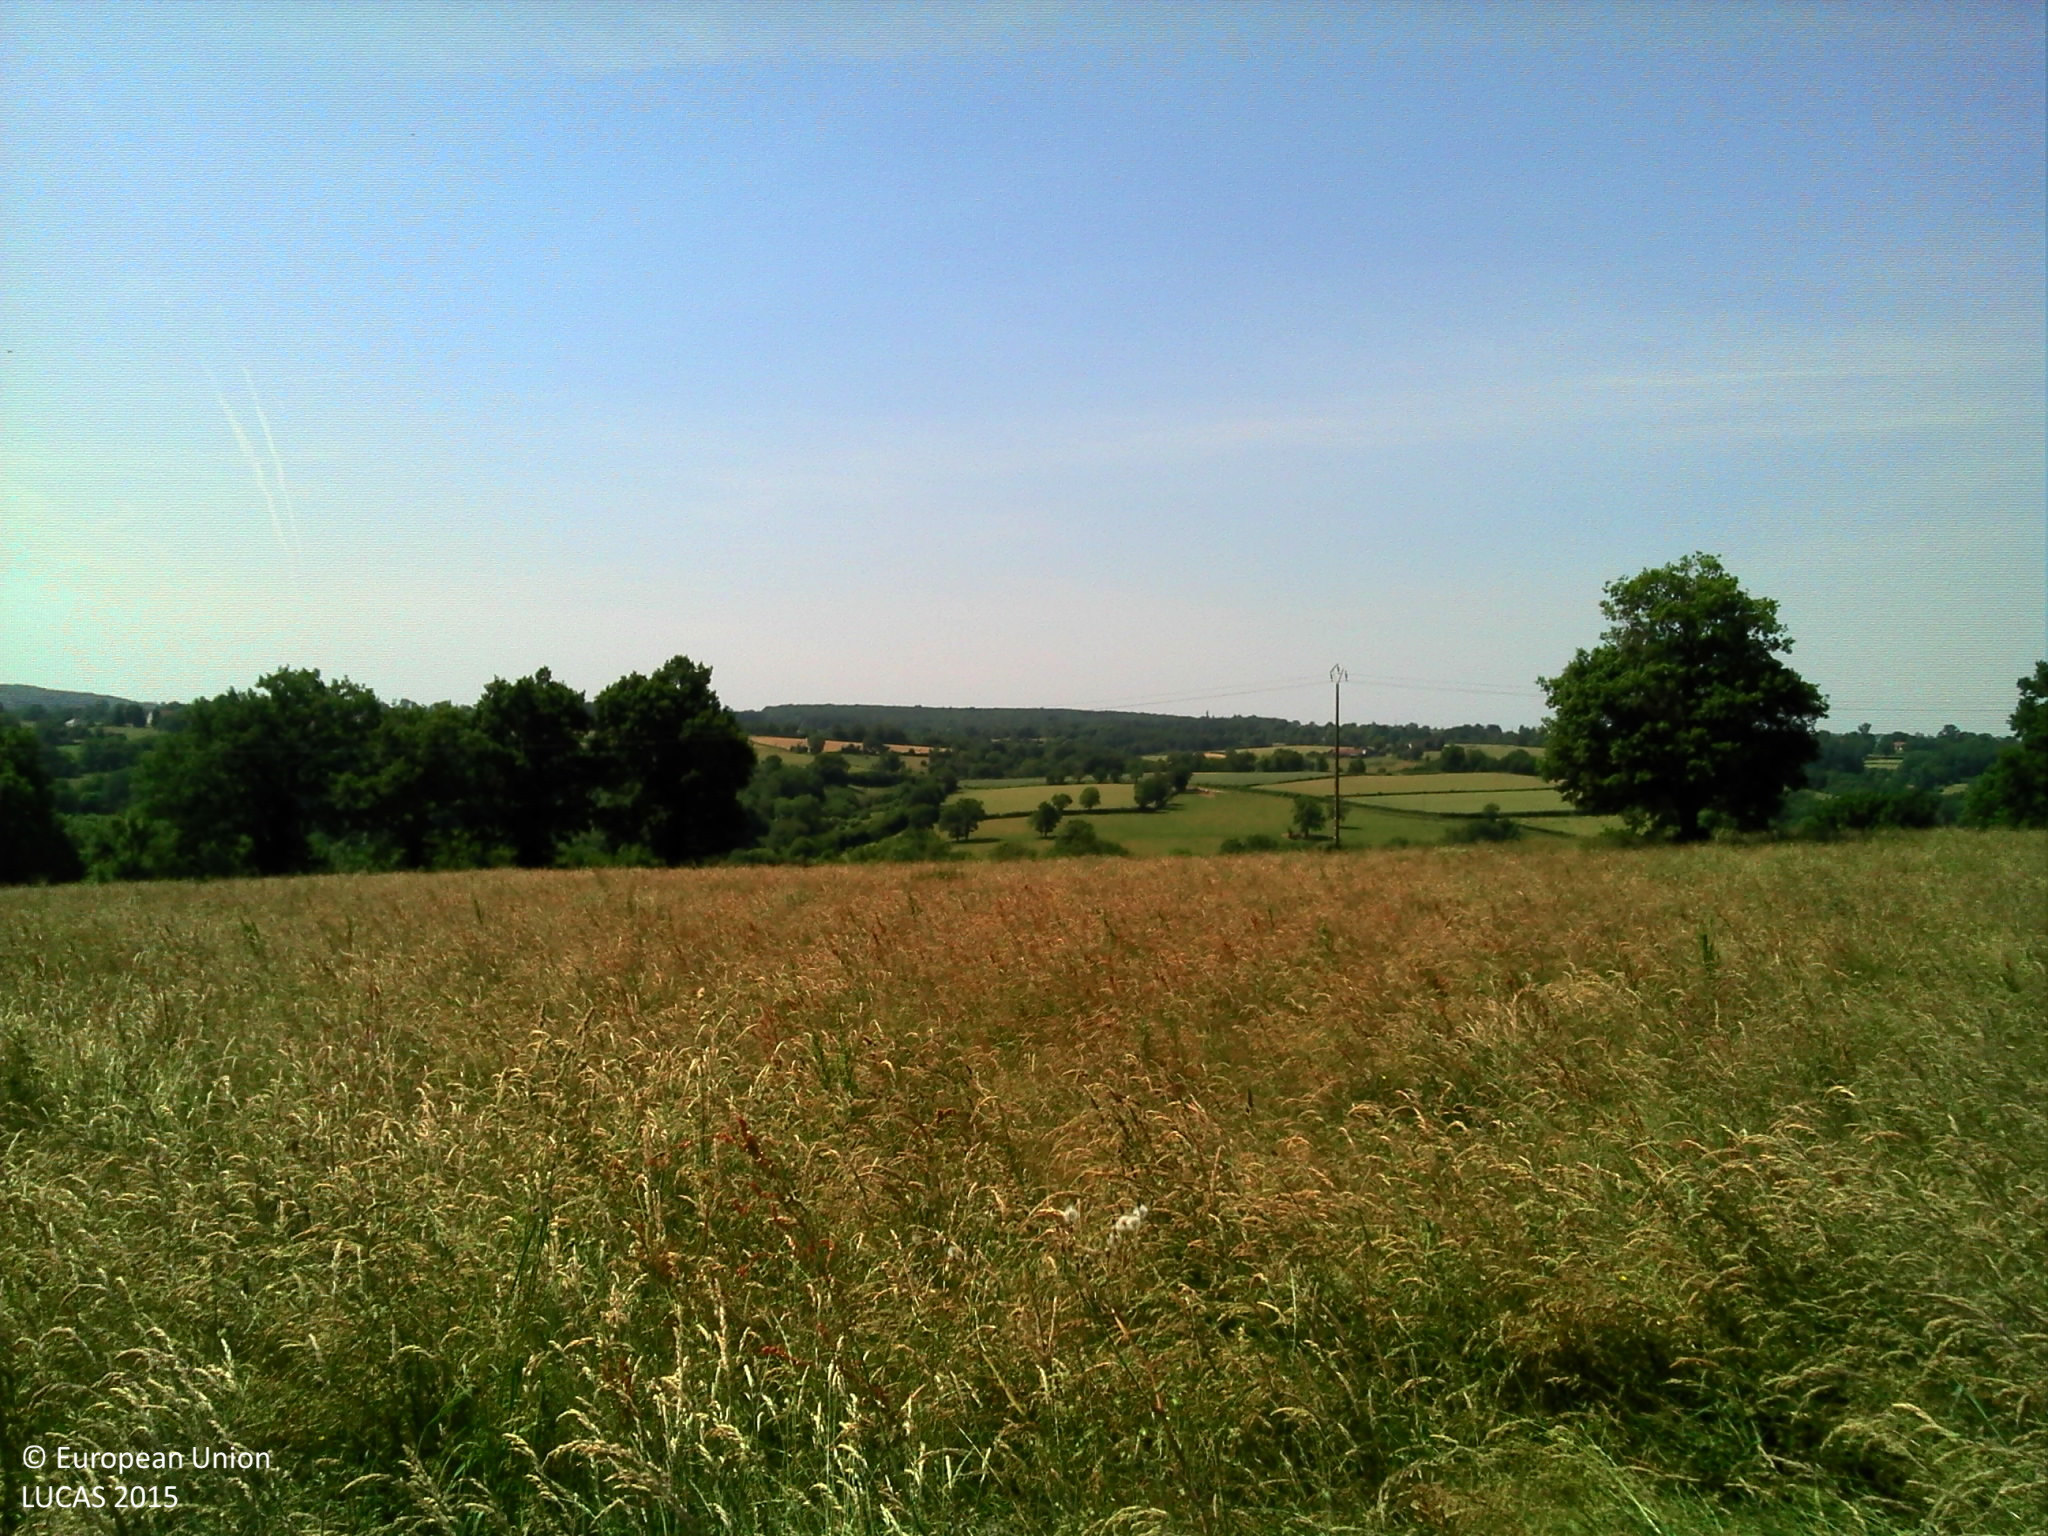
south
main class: Grassland
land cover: Grassland without tree/shrub cover
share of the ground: > 75 %
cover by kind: herbaceous plants 100 %
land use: Agriculture (excluding fallow land and kitchen gardens)
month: June
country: FR
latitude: 46.2726
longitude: 2.8213
